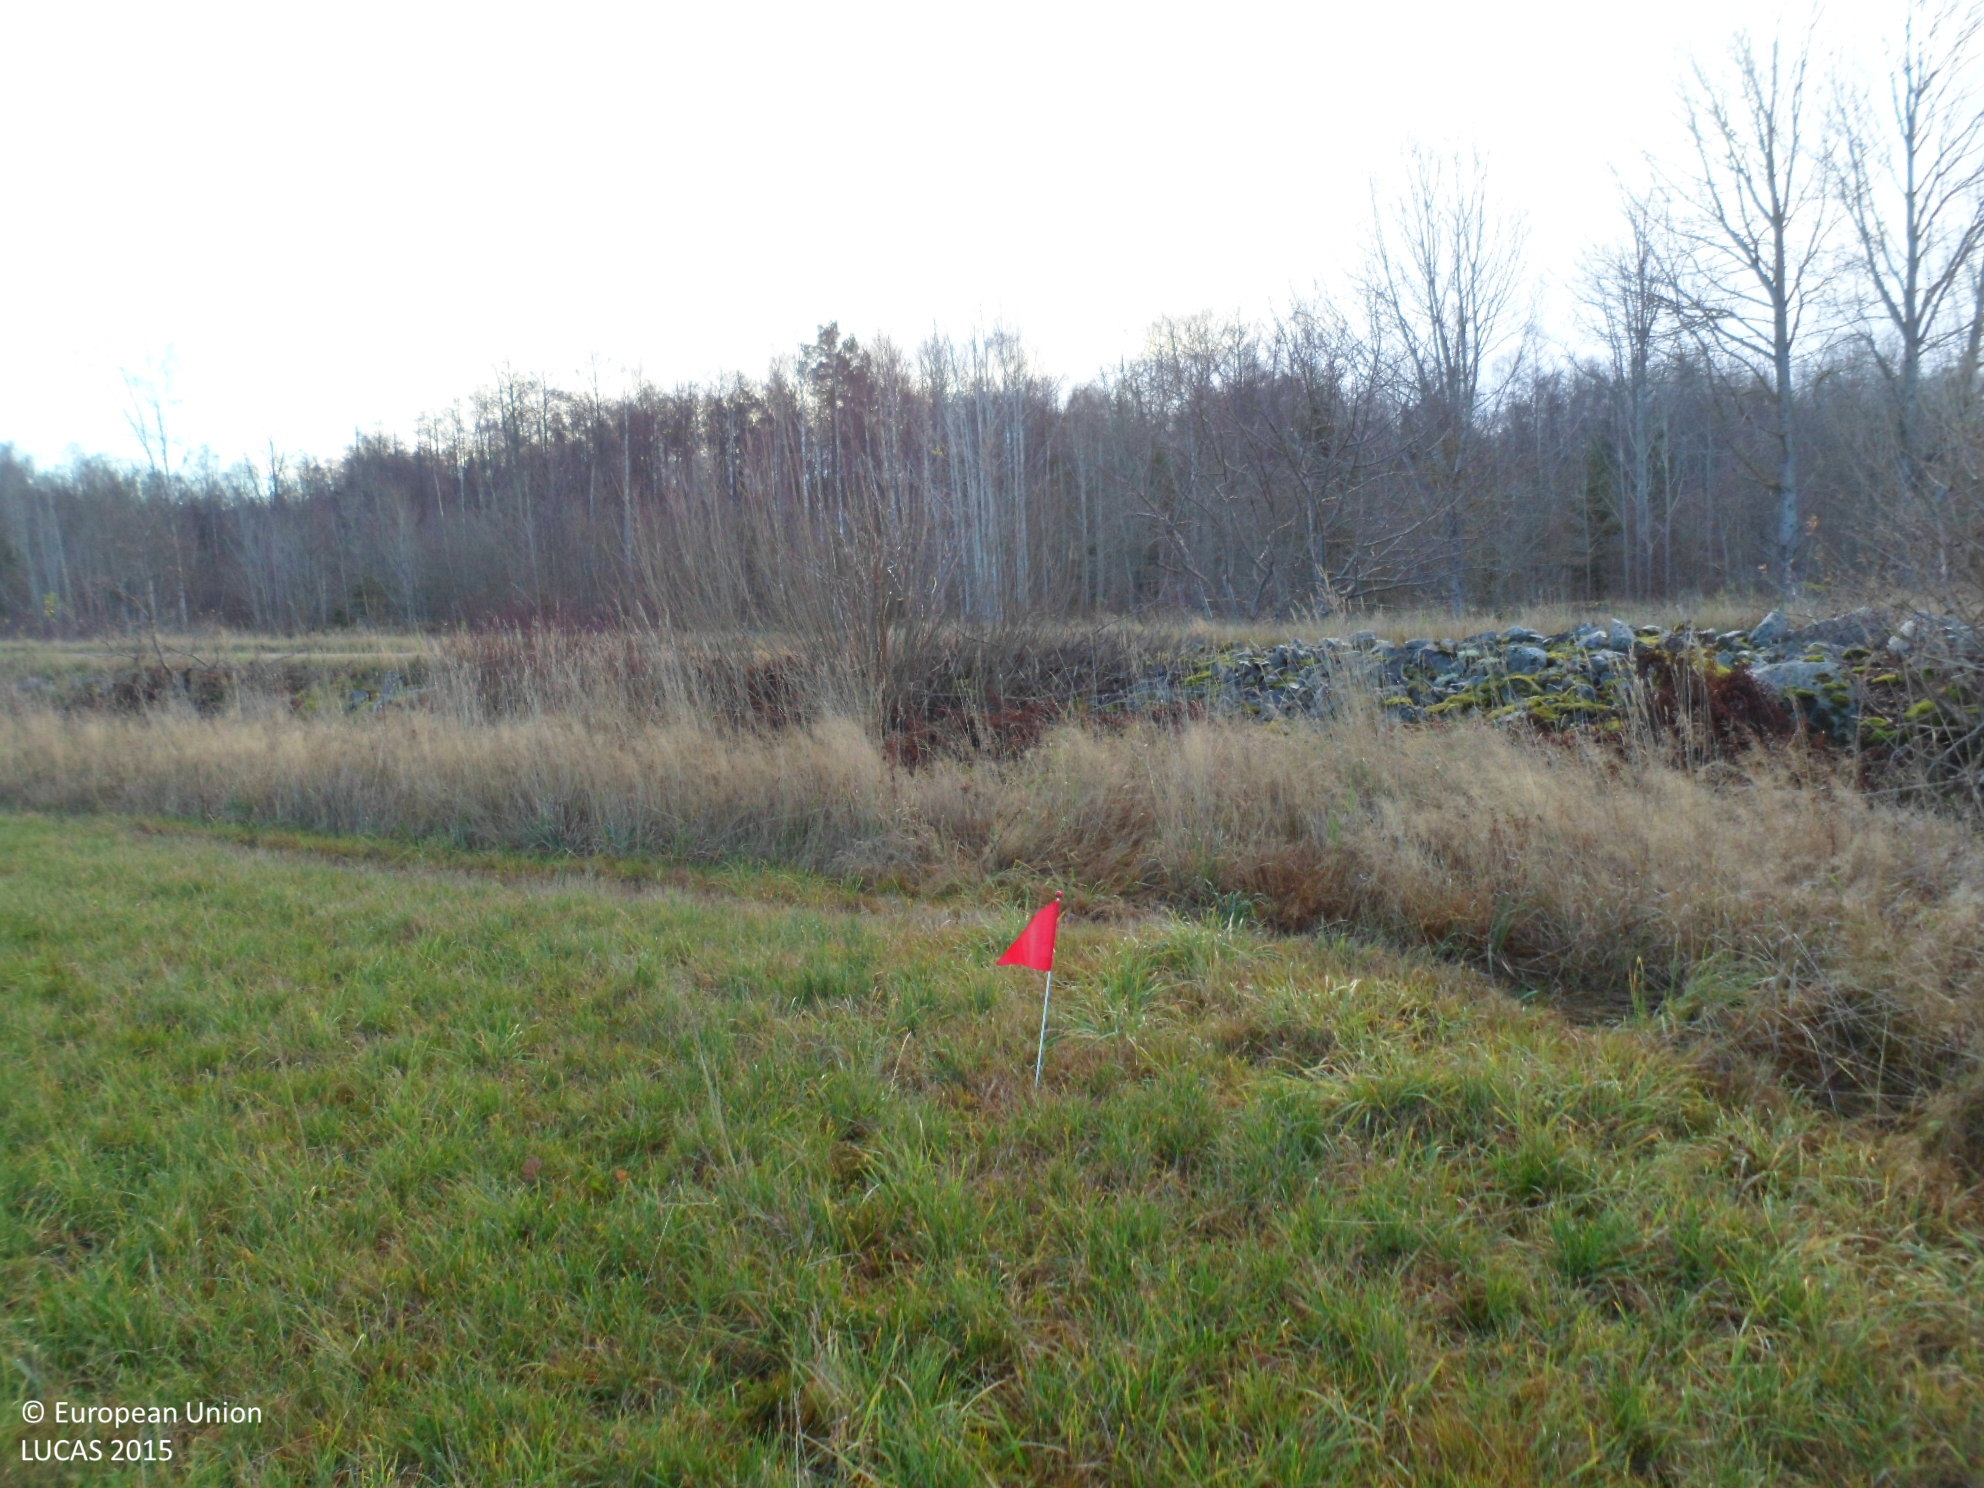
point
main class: Grassland
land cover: Grassland without tree/shrub cover
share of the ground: > 75 %
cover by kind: herbaceous plants 100 %
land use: Agriculture (excluding fallow land and kitchen gardens)
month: November
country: SE
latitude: 56.9536
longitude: 15.9017
